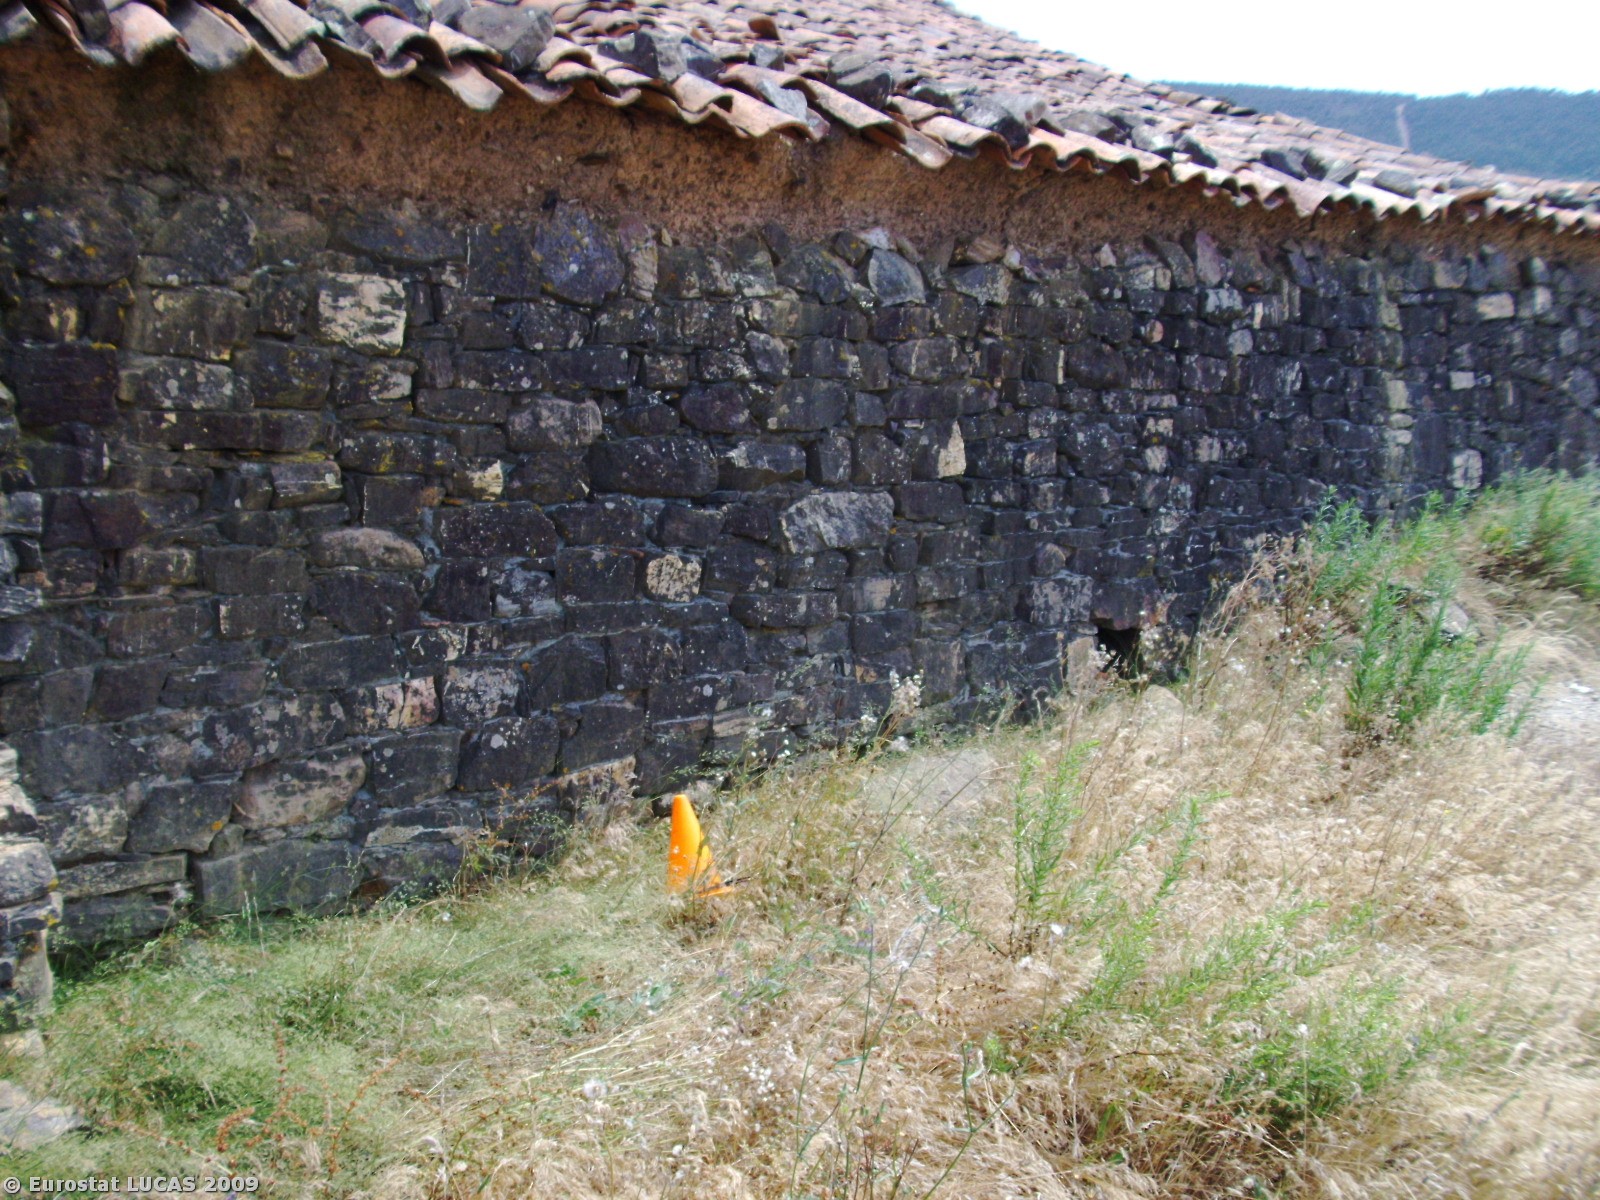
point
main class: Grassland
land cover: Spontaneously vegetated surfaces
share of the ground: > 75 %
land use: Fallow land
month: June
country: PT
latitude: 37.4245
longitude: -8.5531
